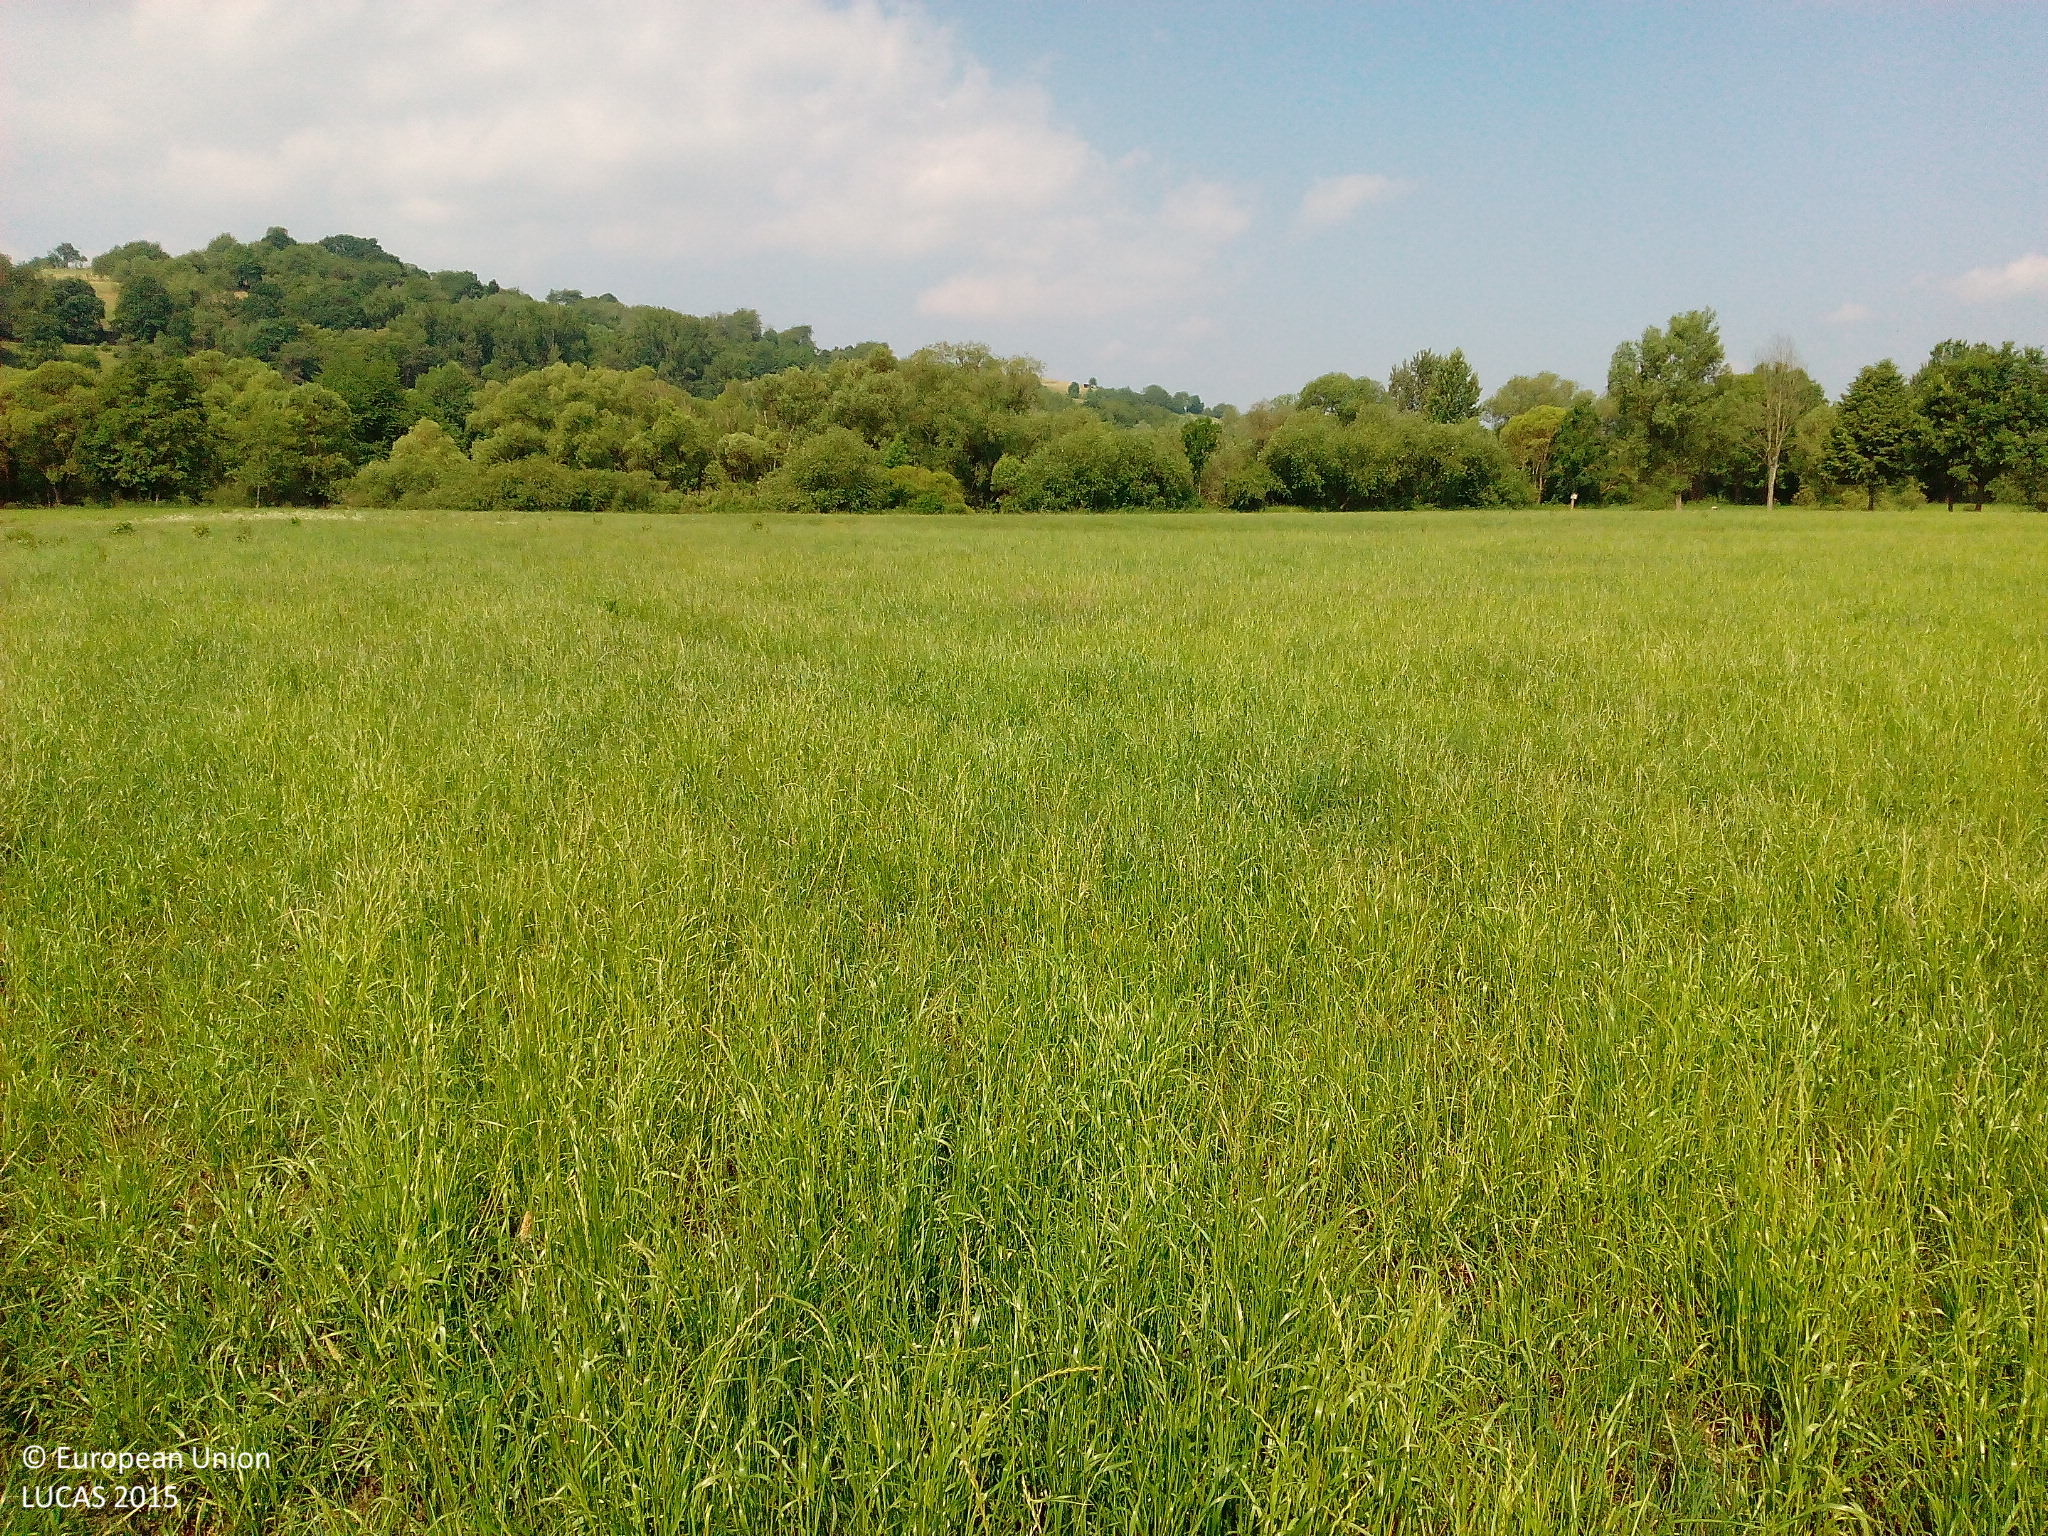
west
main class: Grassland
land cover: Grassland without tree/shrub cover
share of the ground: > 75 %
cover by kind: herbaceous plants 95 %, unconsolidated bare surface 5 %
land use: Agriculture (excluding fallow land and kitchen gardens)
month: June
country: DE
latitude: 51.0288
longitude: 9.6722
